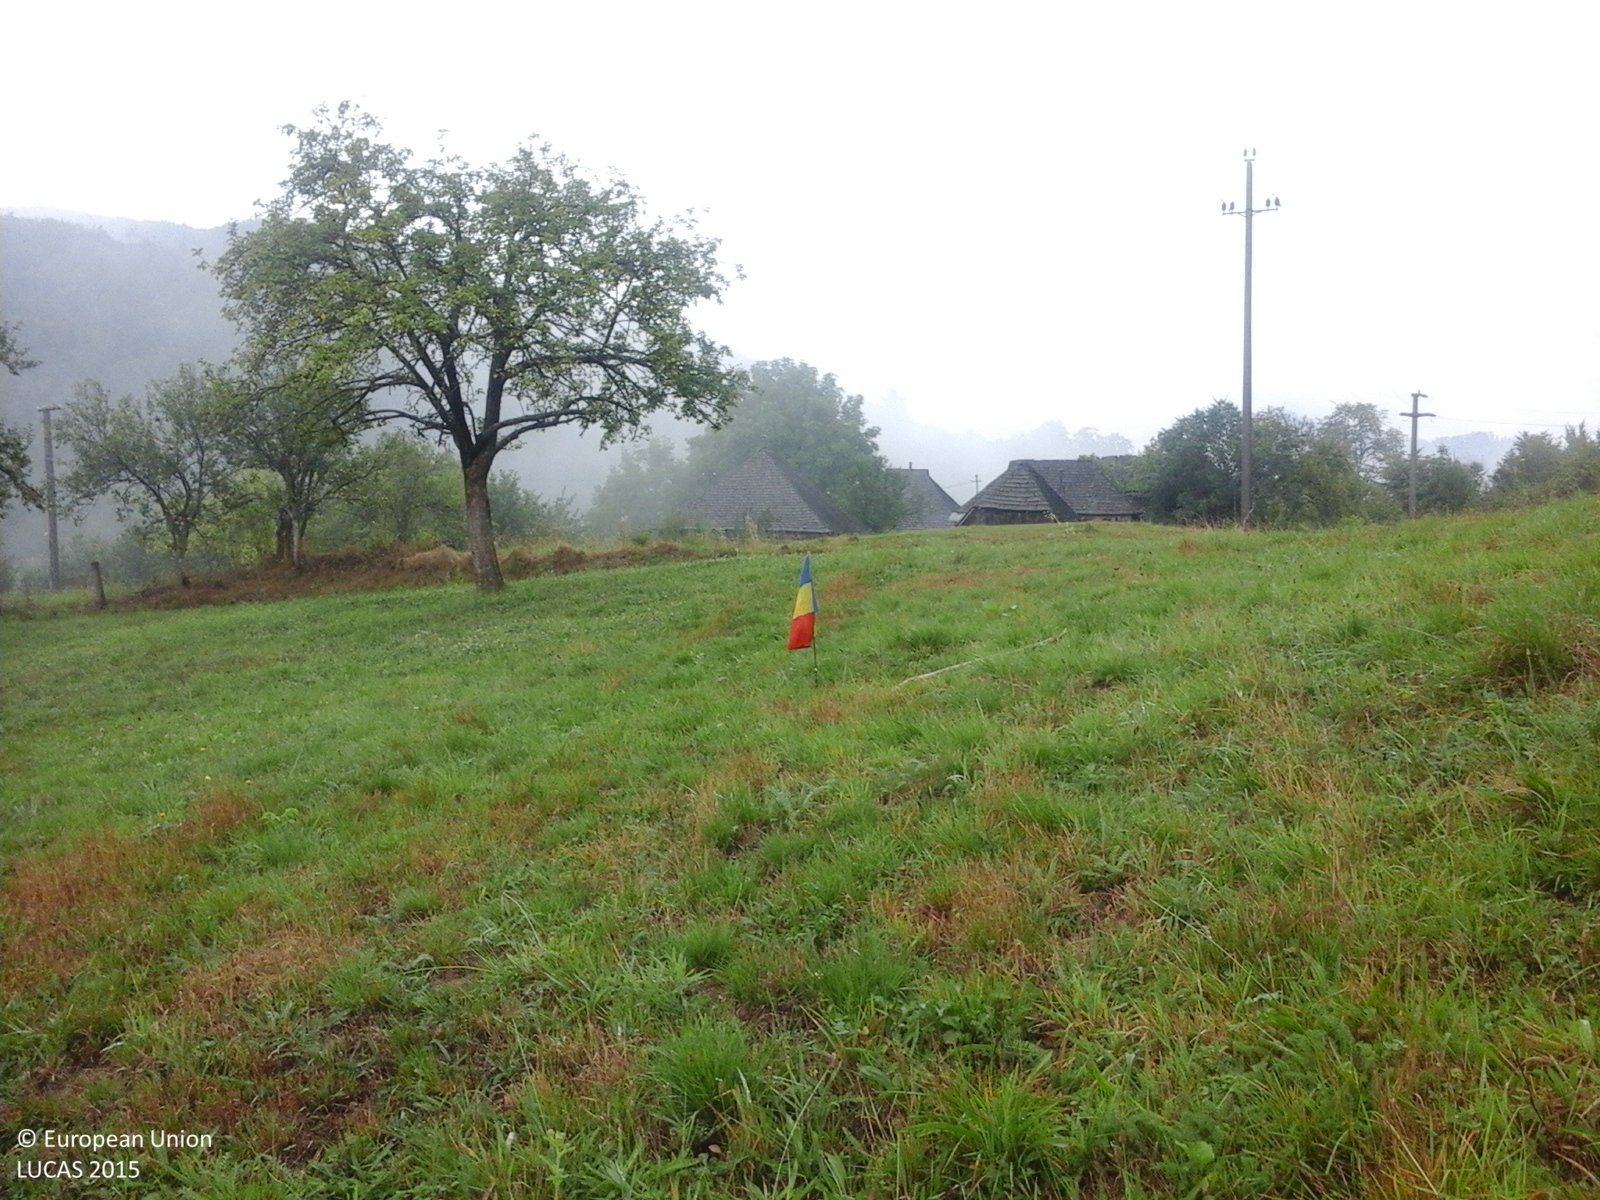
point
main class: Grassland
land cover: Grassland without tree/shrub cover
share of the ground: > 75 %
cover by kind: herbaceous plants 100 %
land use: Agriculture (excluding fallow land and kitchen gardens)
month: September
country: RO
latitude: 47.6008
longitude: 23.9827
